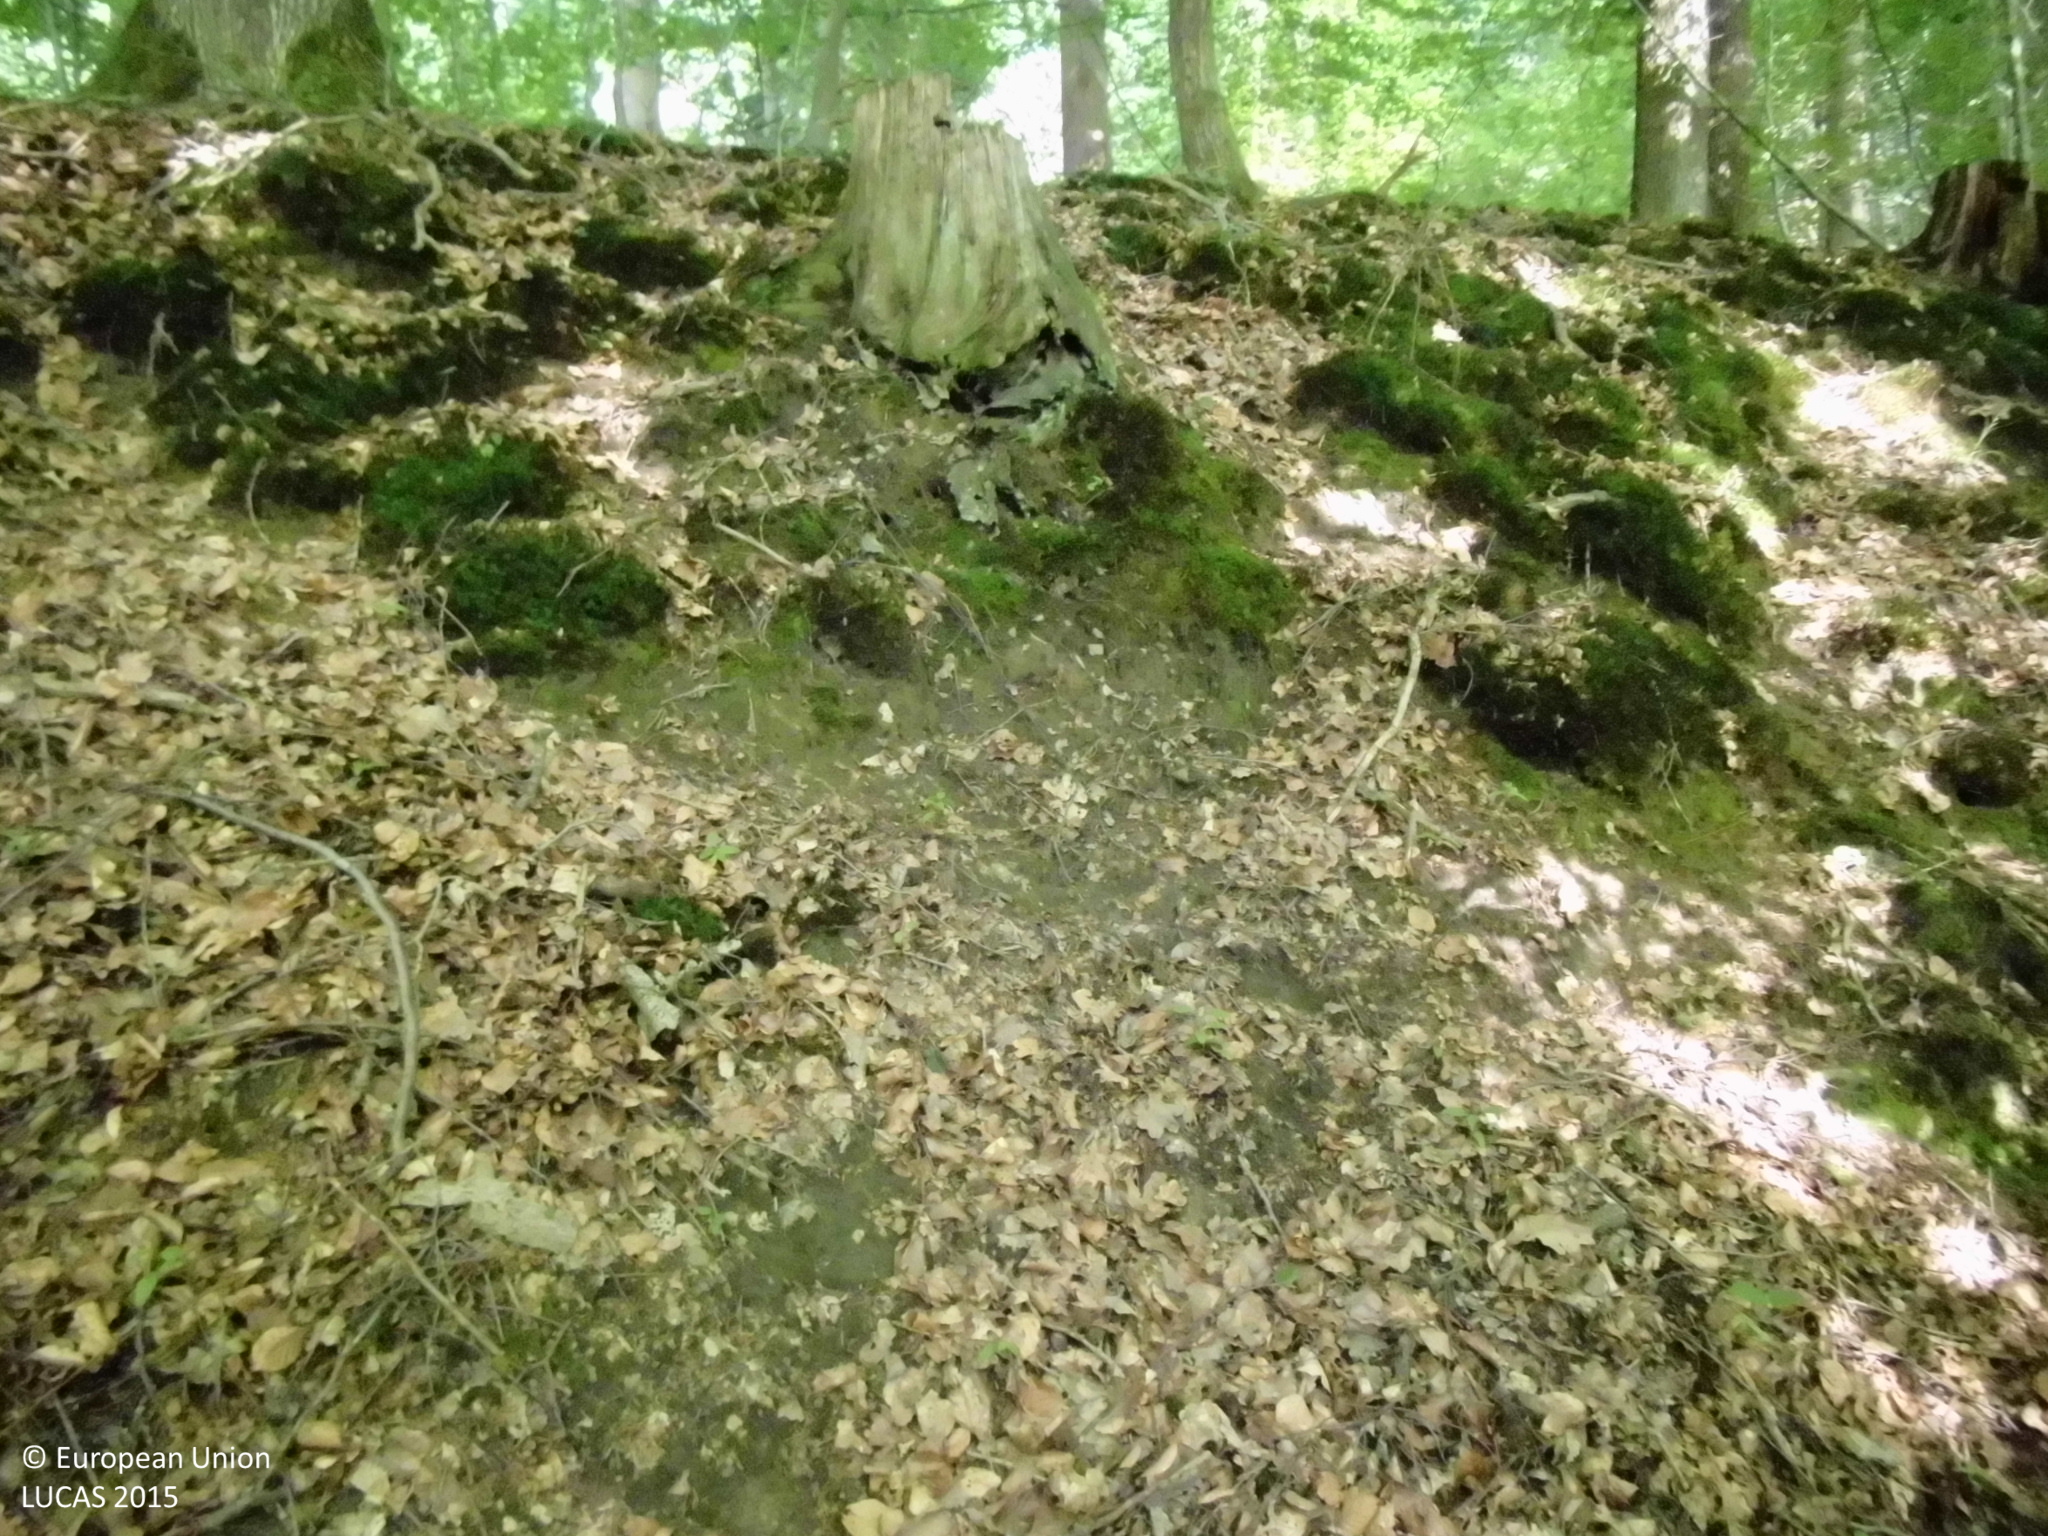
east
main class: Woodland
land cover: Broadleaved woodland
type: beech forest
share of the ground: > 75 %
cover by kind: broadleaved forest trees 90 %, coniferous forest trees 10 %
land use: Forestry
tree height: > 5 m
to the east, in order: Broadleaved woodland; Other coniferous woodland; Spontaneously vegetated surfaces; Spruce dominated coniferous woodland; Tracks; Spruce dominated mixed woodland; Broadleaved woodland
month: June
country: DE
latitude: 50.7491
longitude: 7.4349
